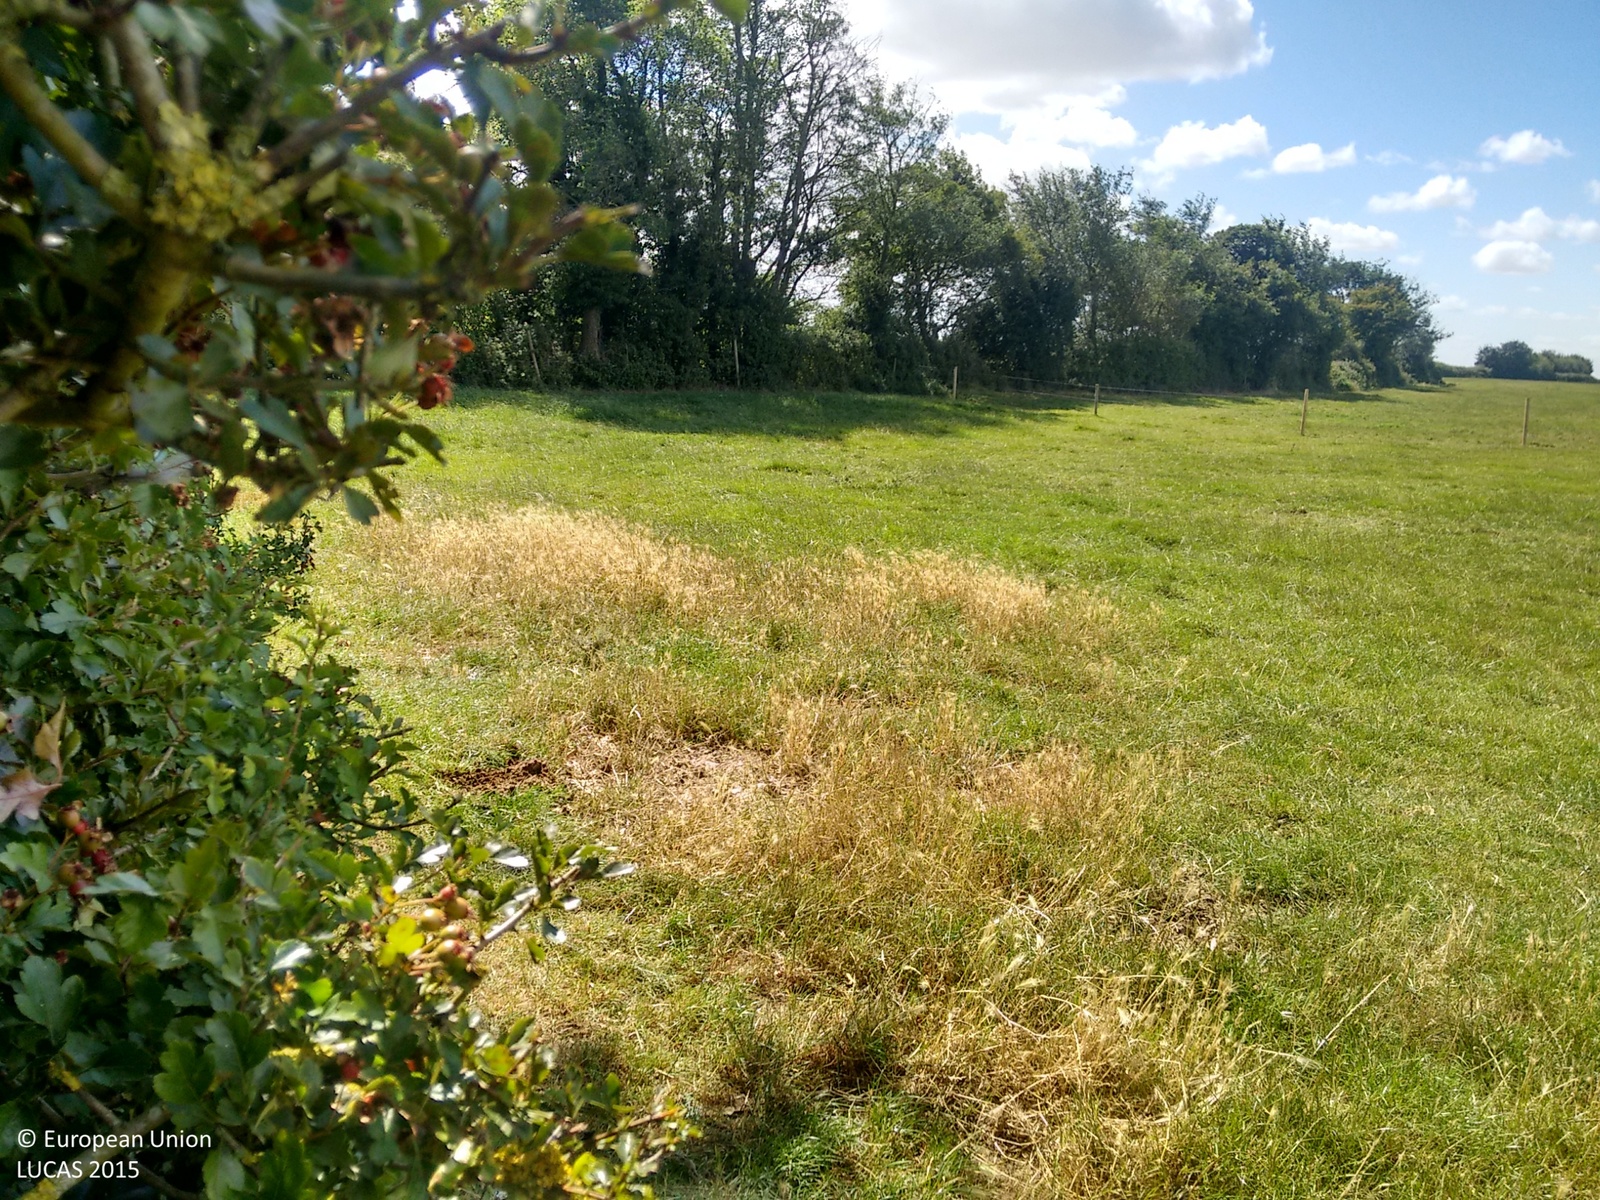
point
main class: Grassland
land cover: Grassland without tree/shrub cover
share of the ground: > 75 %
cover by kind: herbaceous plants 100 %
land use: Agriculture (excluding fallow land and kitchen gardens)
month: August
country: GB
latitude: 52.0591
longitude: 0.3888
